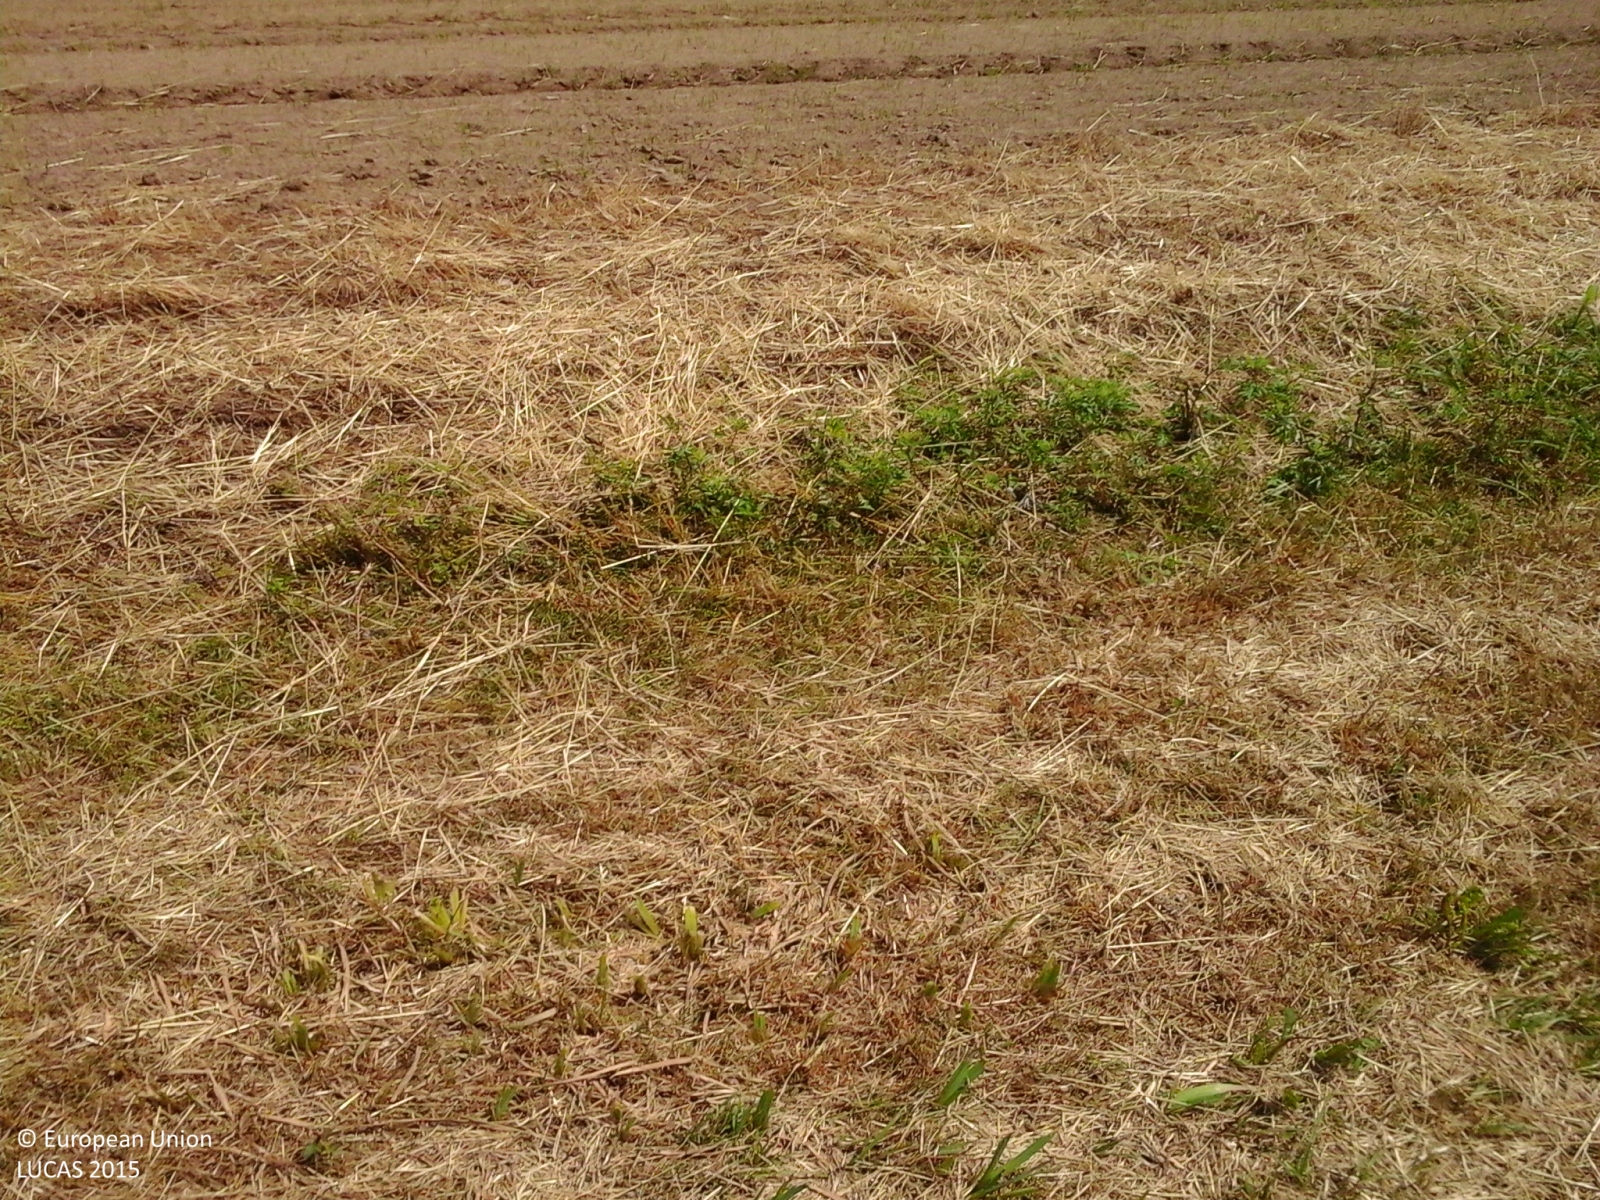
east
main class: Cropland
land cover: Rice
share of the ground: < 10 %
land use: Agriculture (excluding fallow land and kitchen gardens)
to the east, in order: Rice; Grassland without tree/shrub cover; Rice; Grass margins; Ditches and canals; Grass margins; Tracks; Grass margins; Rice; Tracks
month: May
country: IT
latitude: 45.2482
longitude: 9.0970
